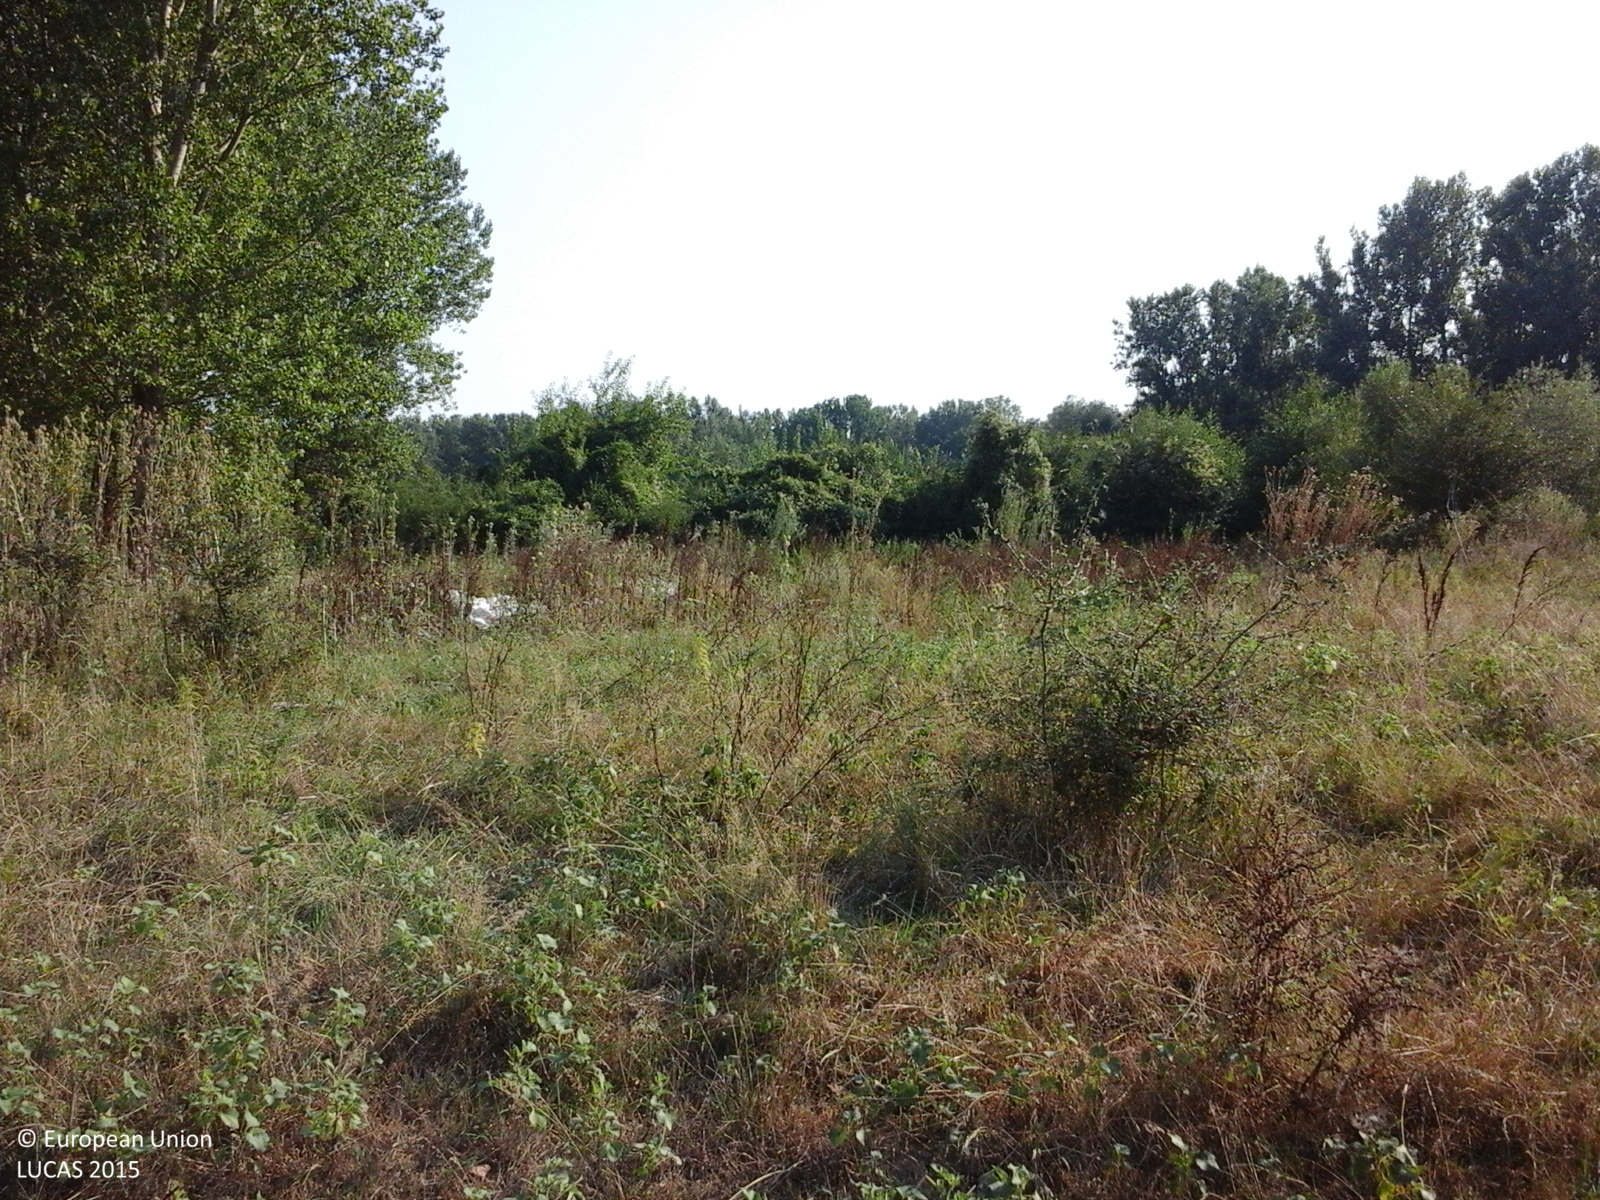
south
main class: Grassland
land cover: Spontaneously vegetated surfaces
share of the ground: > 75 %
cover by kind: herbaceous plants 100 %
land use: Fallow land
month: August
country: RO
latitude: 44.4919
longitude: 23.5984
